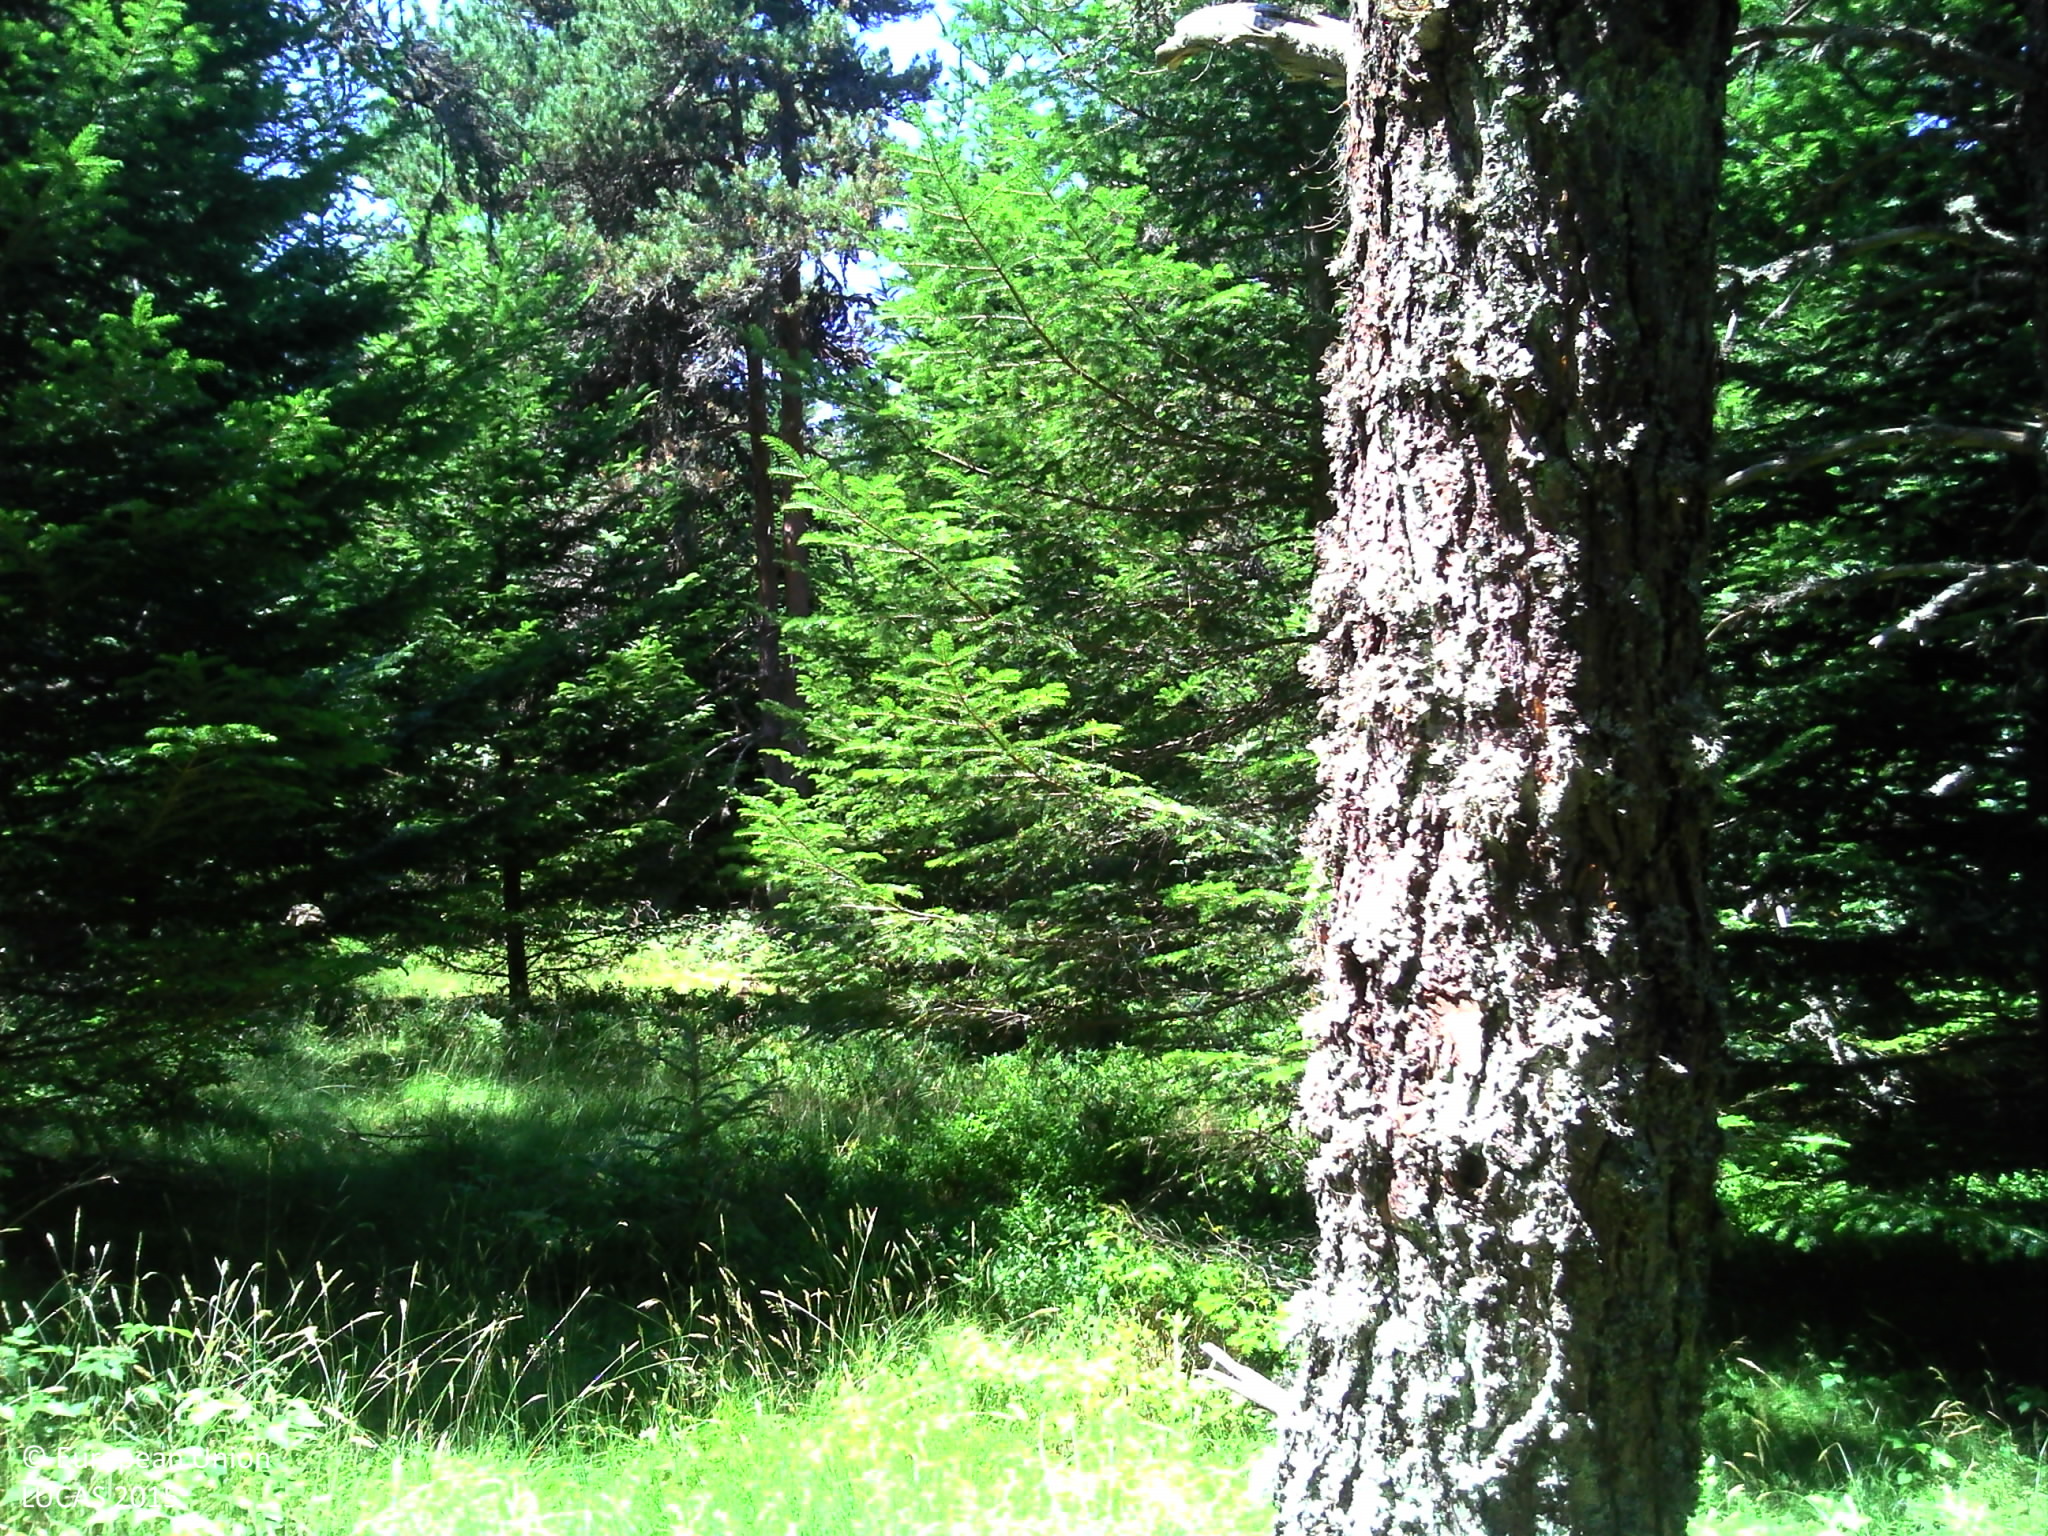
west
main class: Woodland
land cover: Spruce dominated coniferous woodland
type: exotic forest
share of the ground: > 75 %
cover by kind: coniferous forest trees 80 %, shrubs 10 %, herbaceous plants 10 %
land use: Forestry
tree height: > 5 m
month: July
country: FR
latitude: 44.9020
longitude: 3.4309
